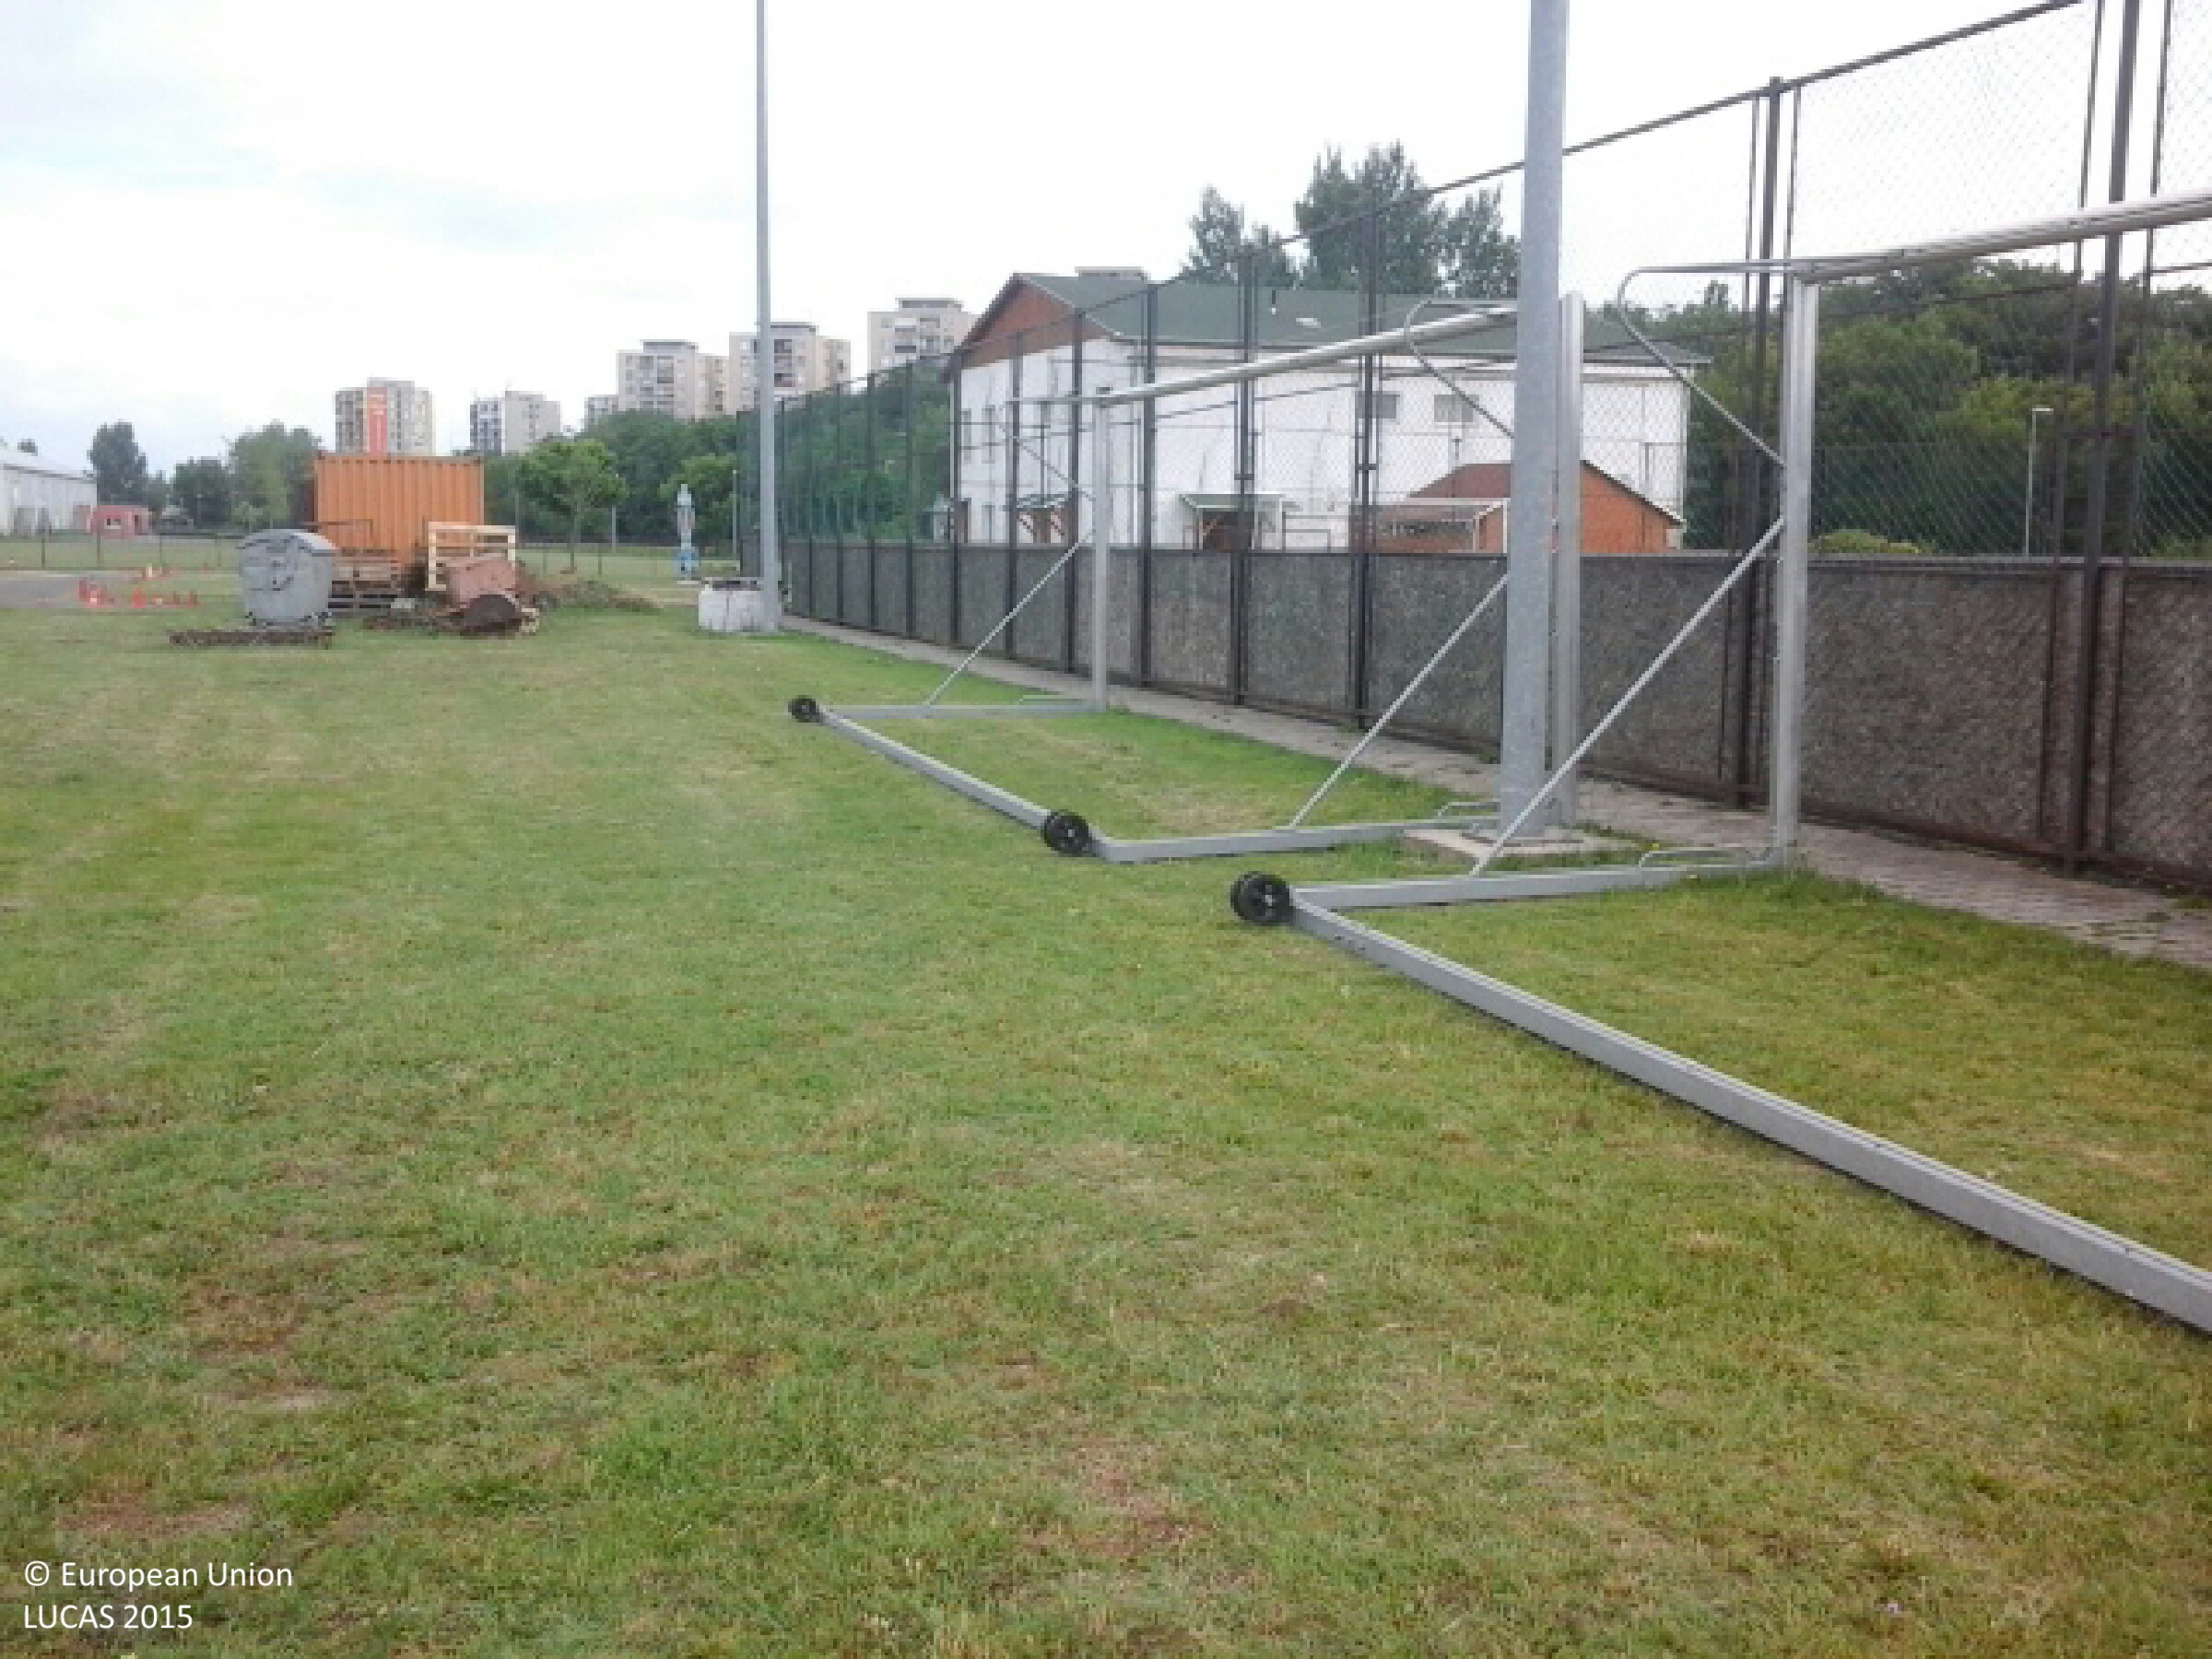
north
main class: Grassland
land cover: Grassland without tree/shrub cover
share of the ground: > 75 %
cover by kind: herbaceous plants 100 %
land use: Sport
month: June
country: HU
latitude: 47.4301
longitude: 19.0994
